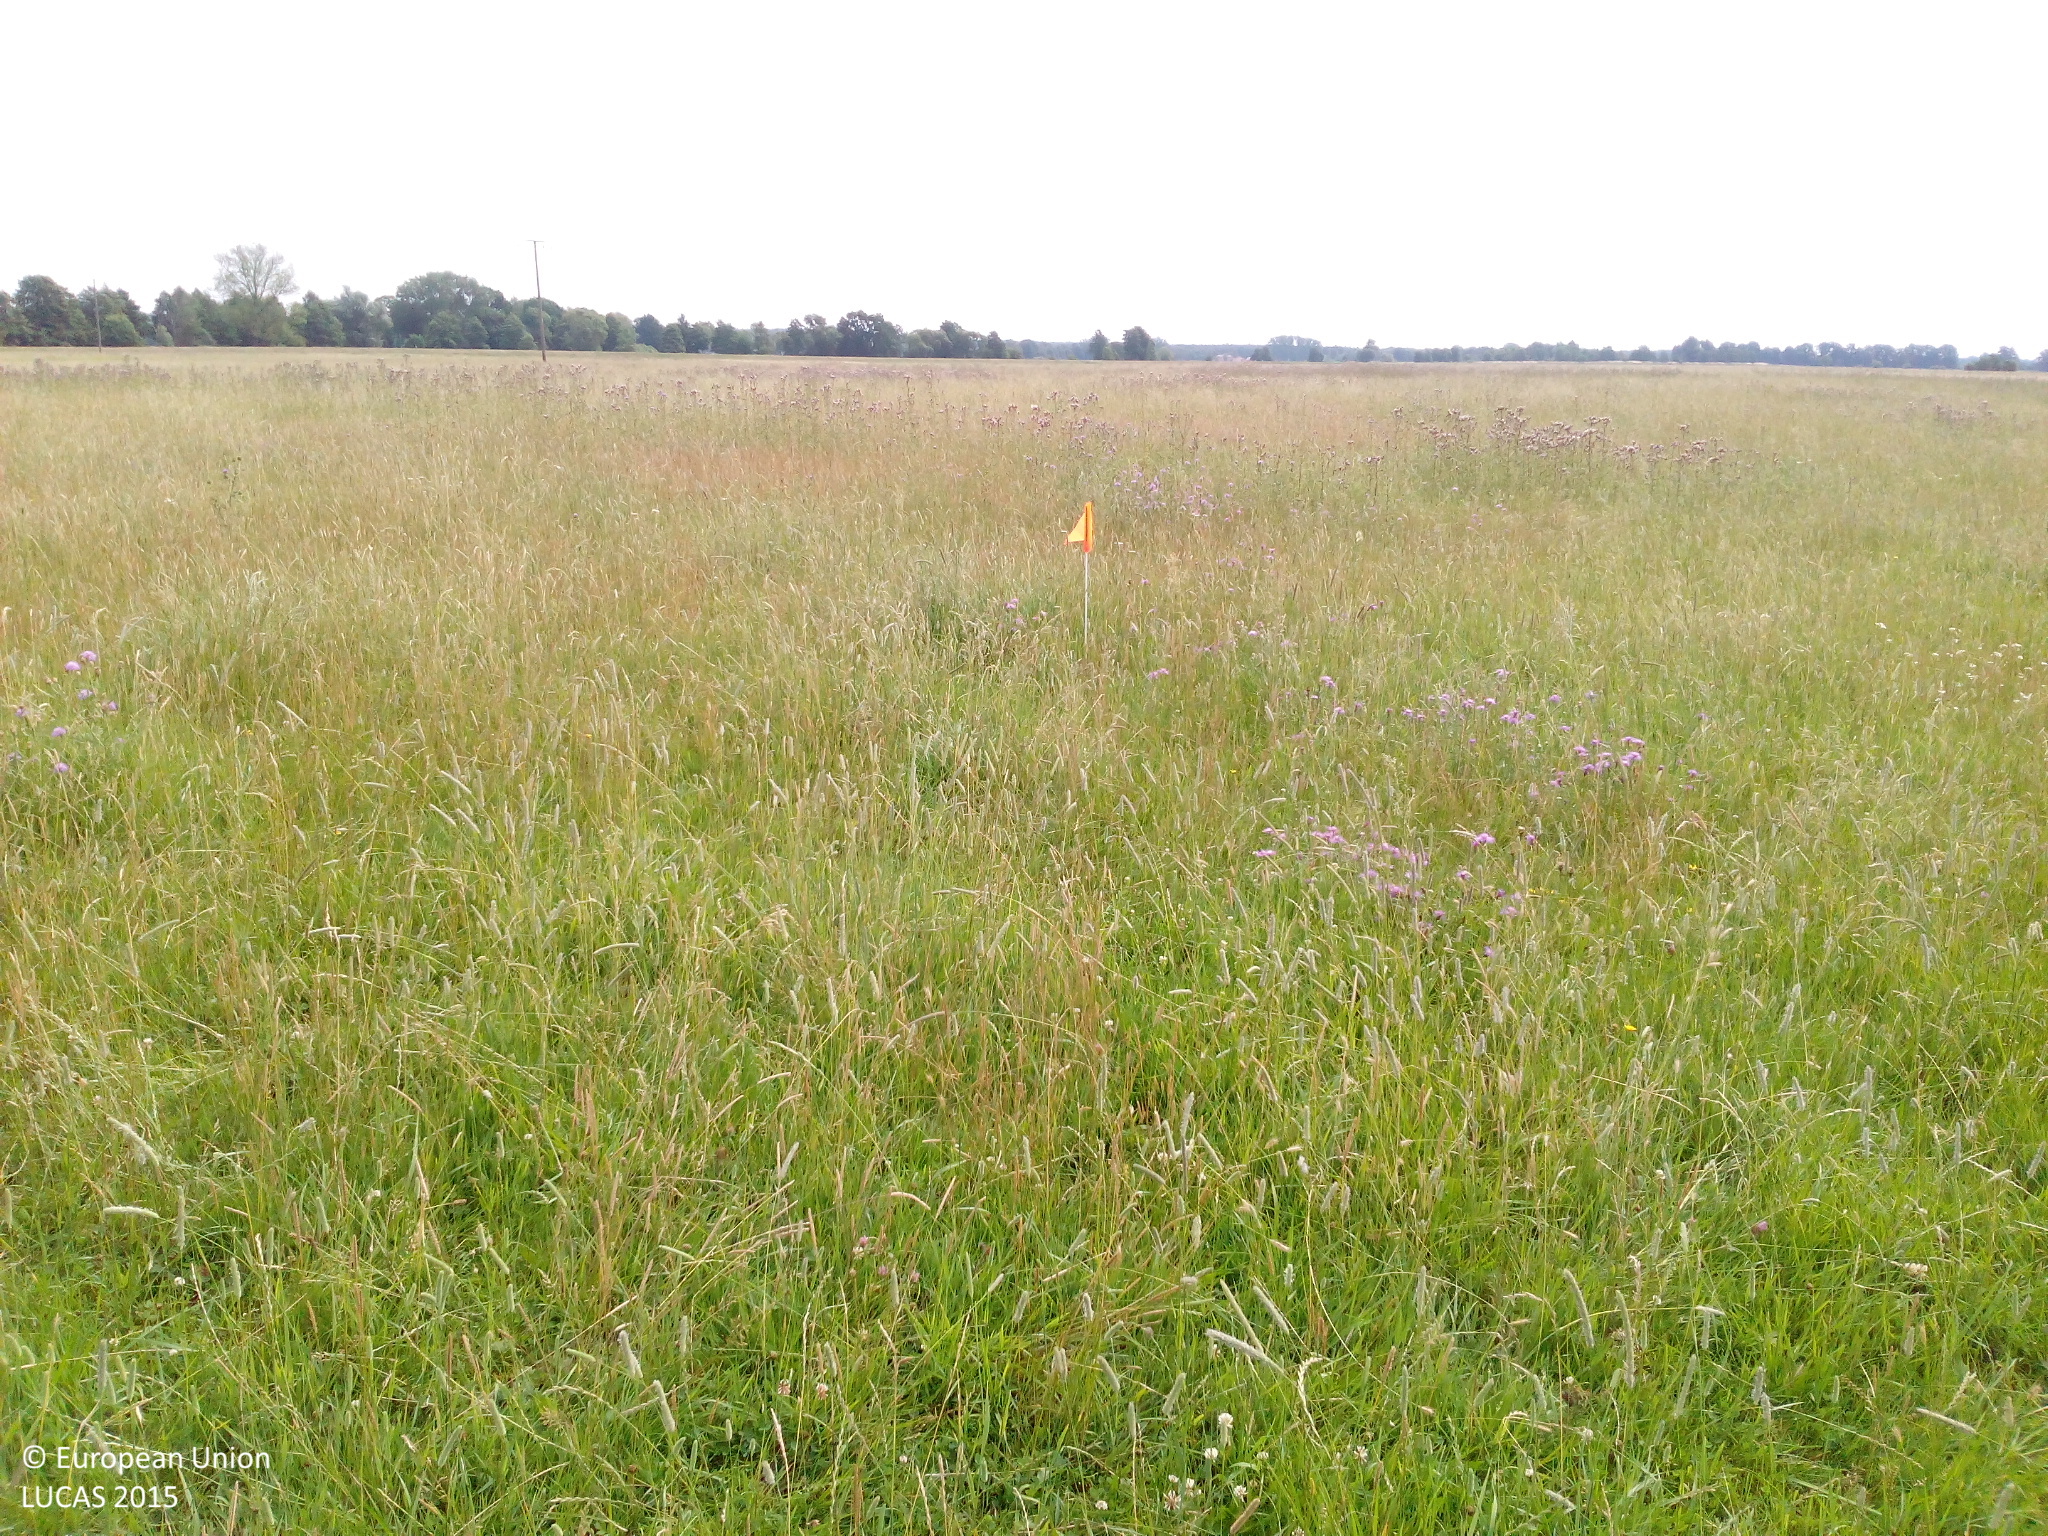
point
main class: Grassland
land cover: Grassland without tree/shrub cover
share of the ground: > 75 %
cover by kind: herbaceous plants 100 %
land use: Agriculture (excluding fallow land and kitchen gardens)
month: July
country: DE
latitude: 53.0873
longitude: 11.4776
